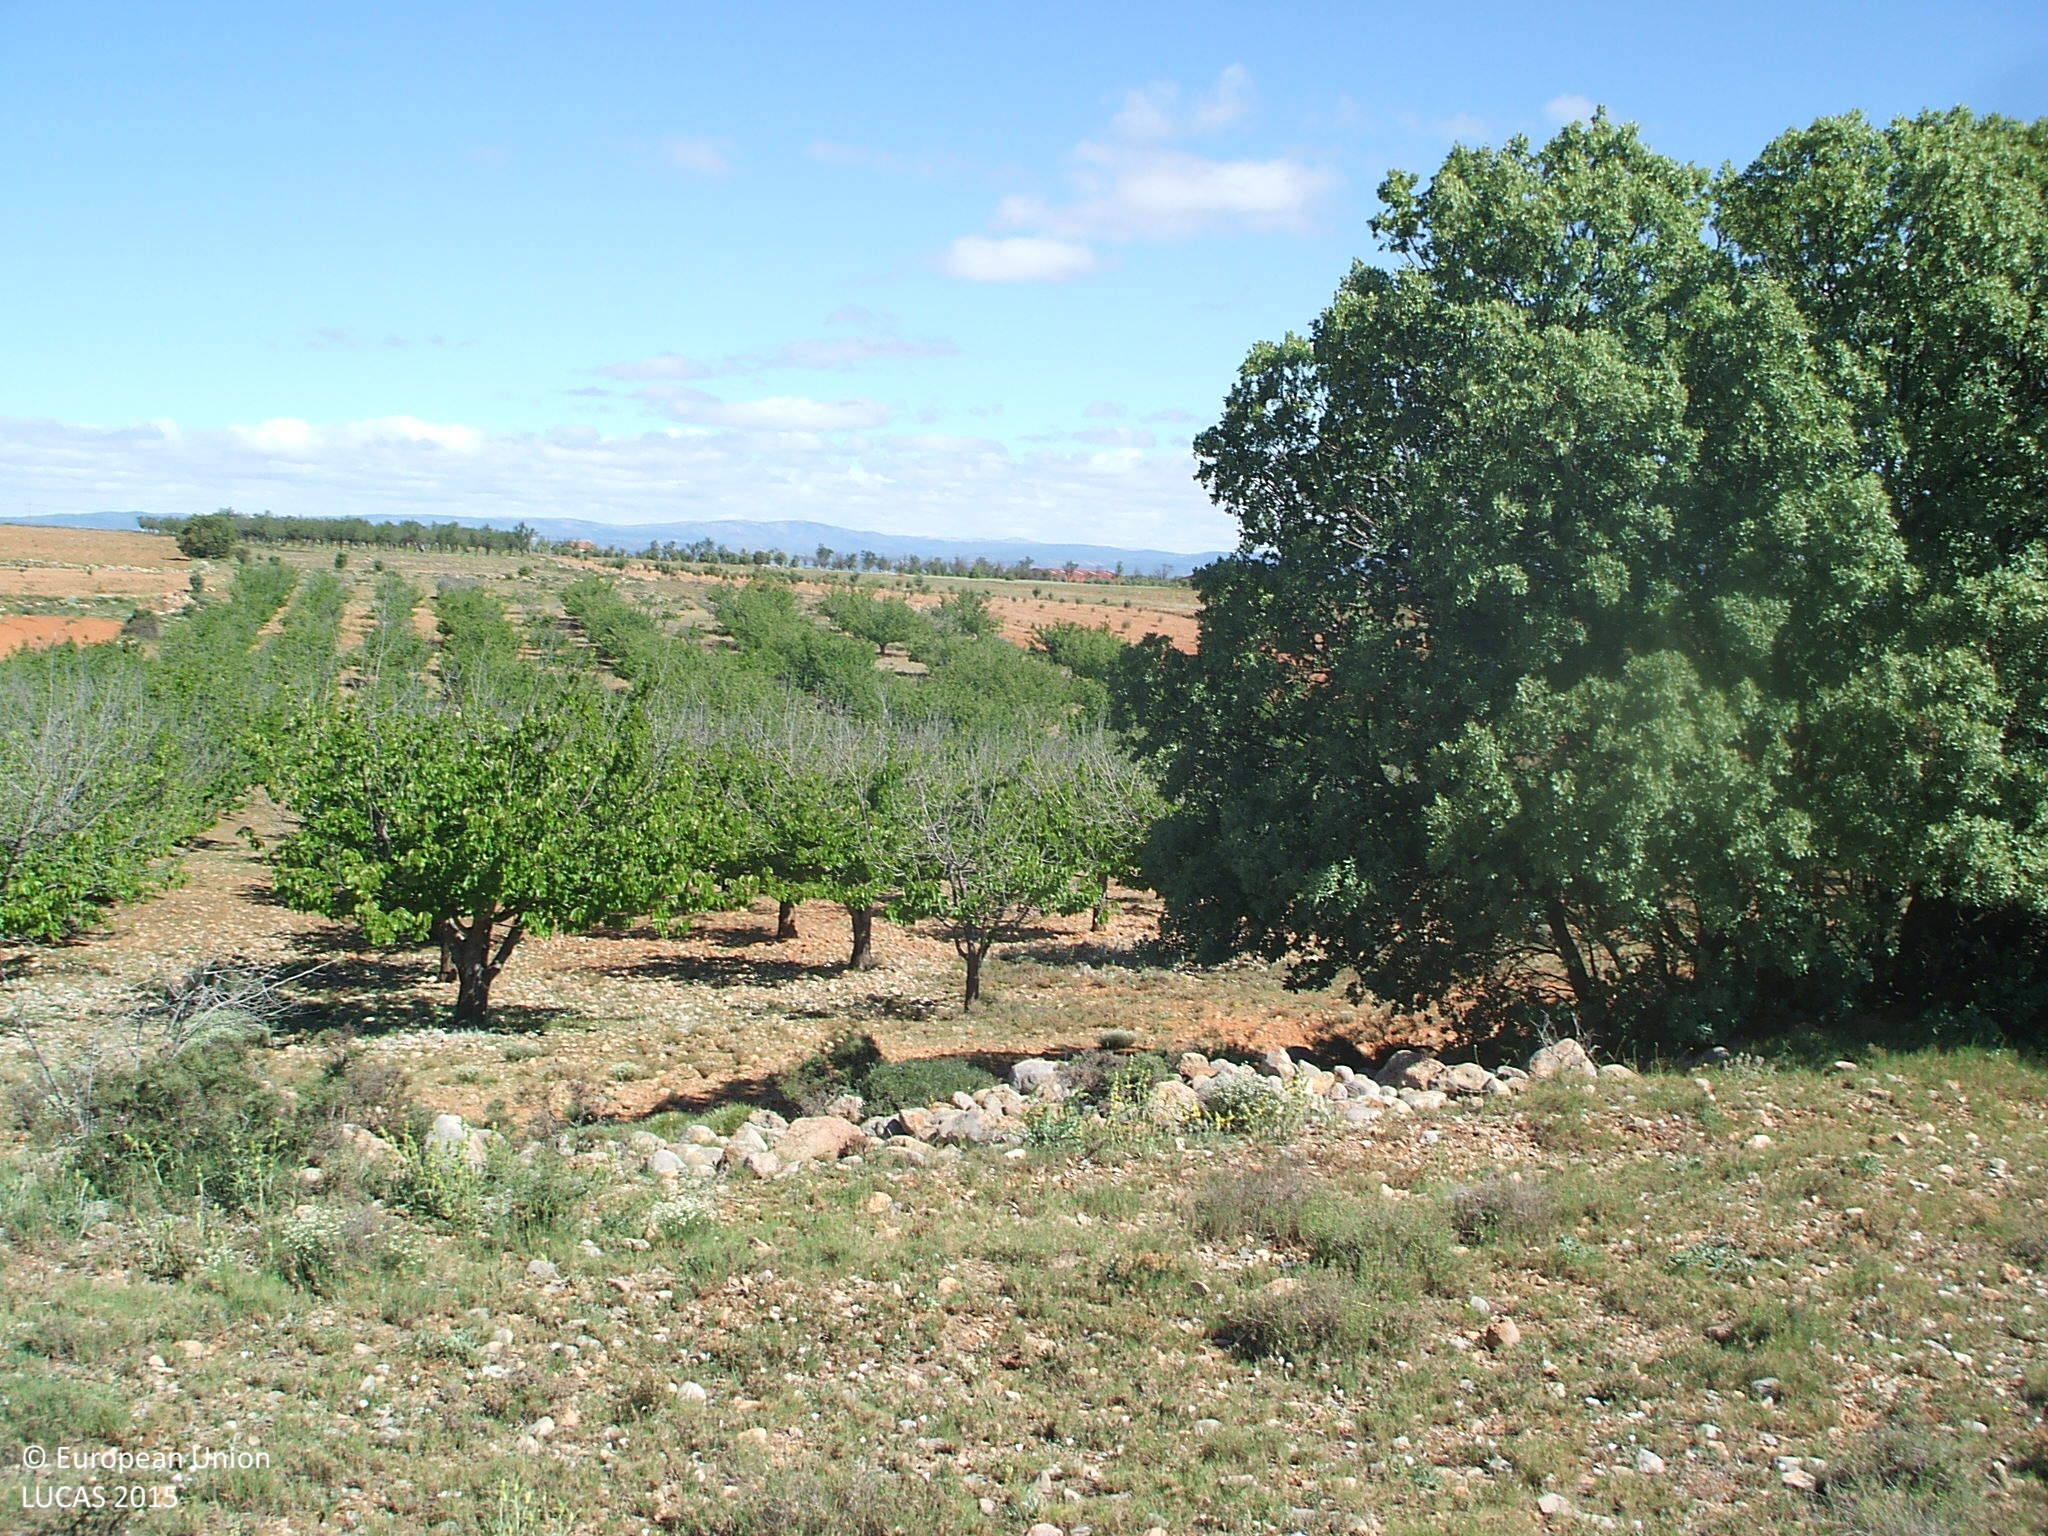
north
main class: Shrubland
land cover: Shrubland without tree cover
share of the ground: 50 - 75 %
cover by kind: consolidated bare surface 60 %, shrubs 20 %, herbaceous plants 20 %
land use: Abandoned areas
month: May
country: ES
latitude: 40.0931
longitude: -0.7615
